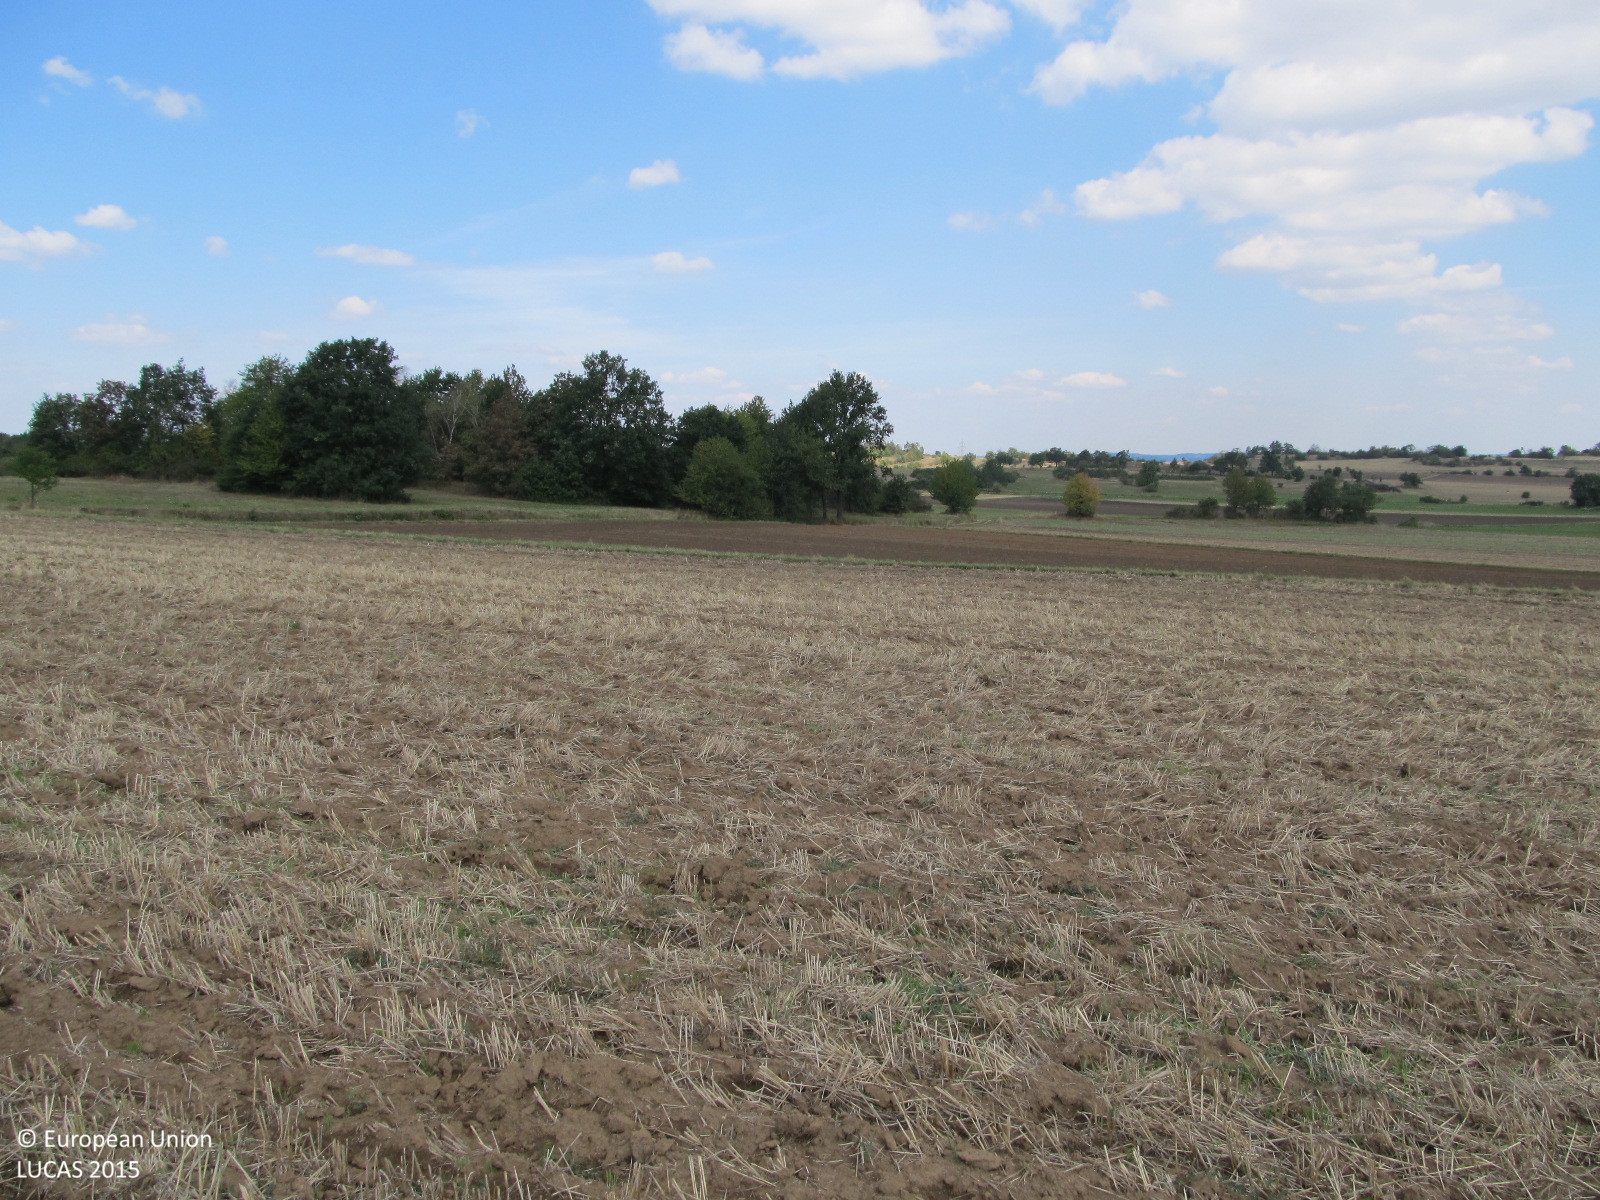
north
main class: Cropland
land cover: Barley
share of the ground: < 10 %
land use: Agriculture (excluding fallow land and kitchen gardens)
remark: Harvested field
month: August
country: AT
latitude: 48.6041
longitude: 15.6041
